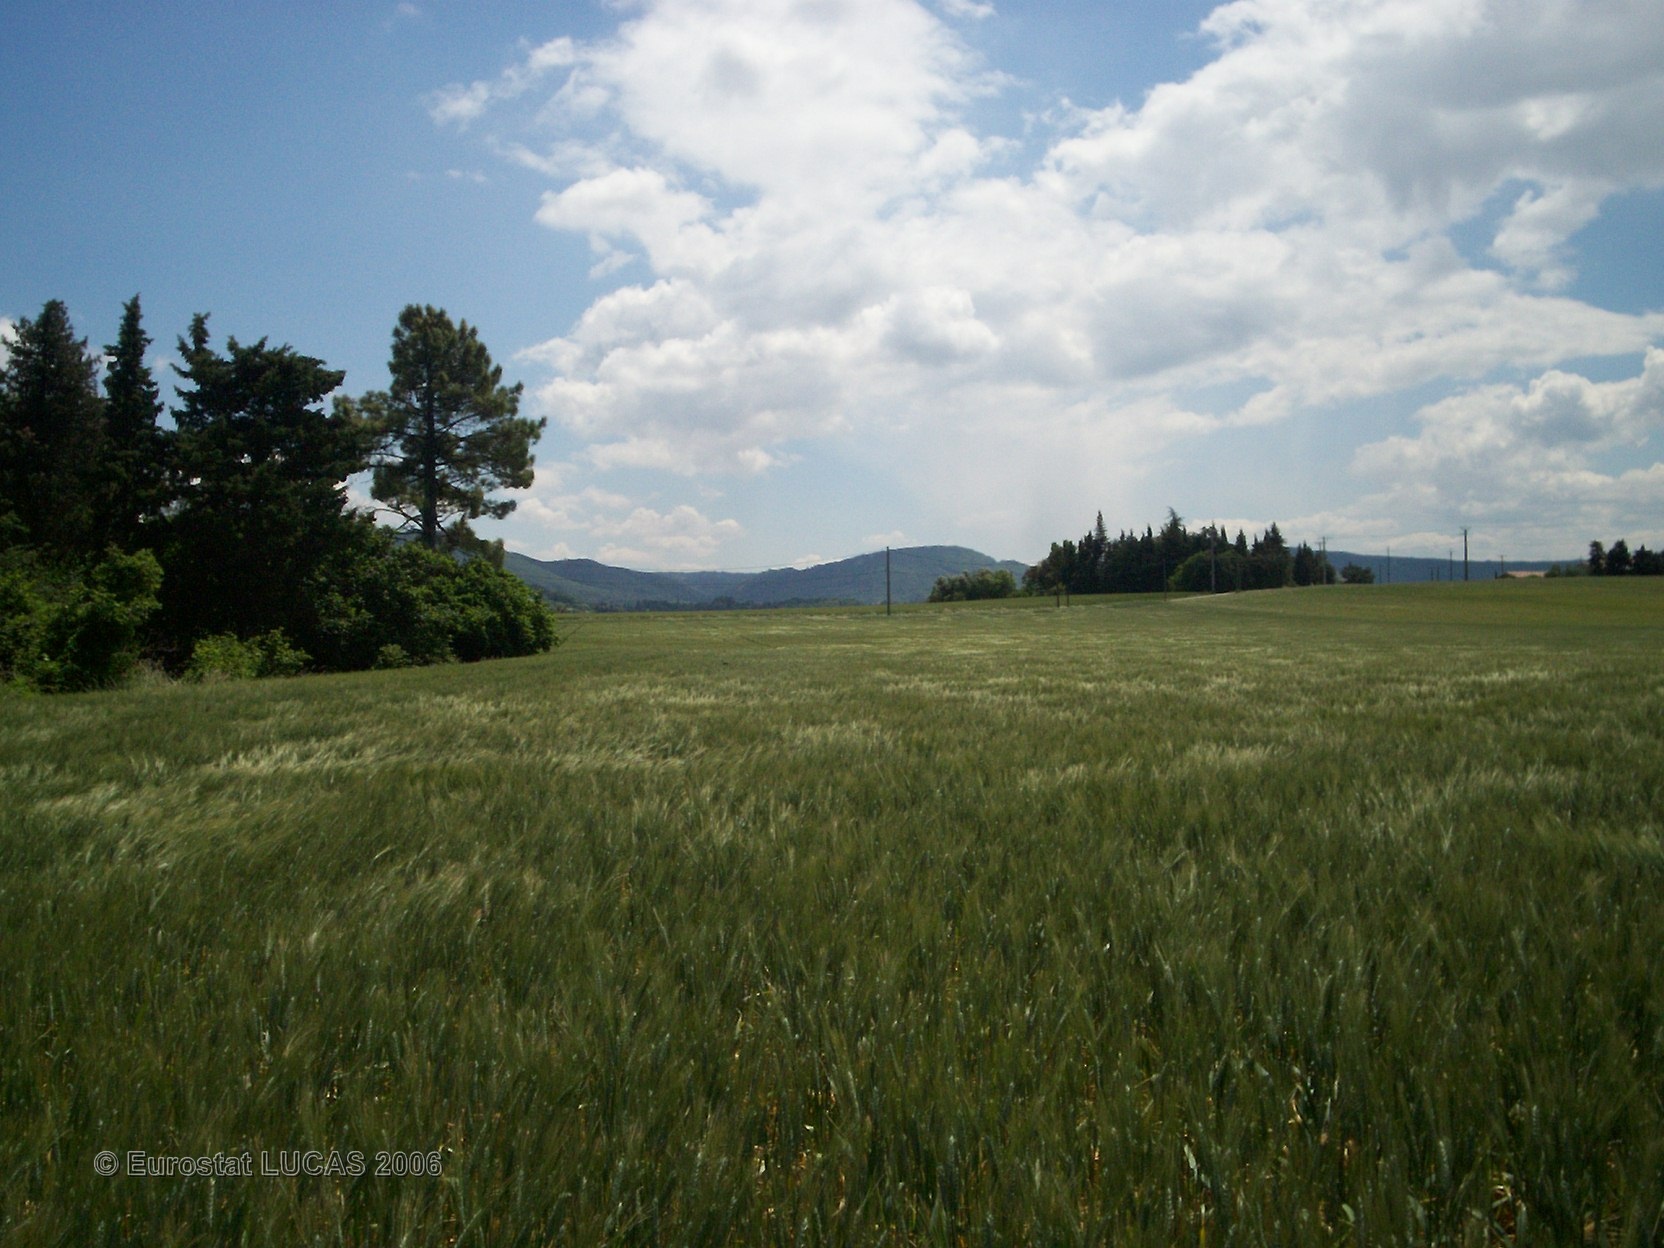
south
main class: Cropland
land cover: Durum wheat
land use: Agriculture (excluding fallow land and kitchen gardens)
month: May
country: FR
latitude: 44.5700
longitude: 4.9322
